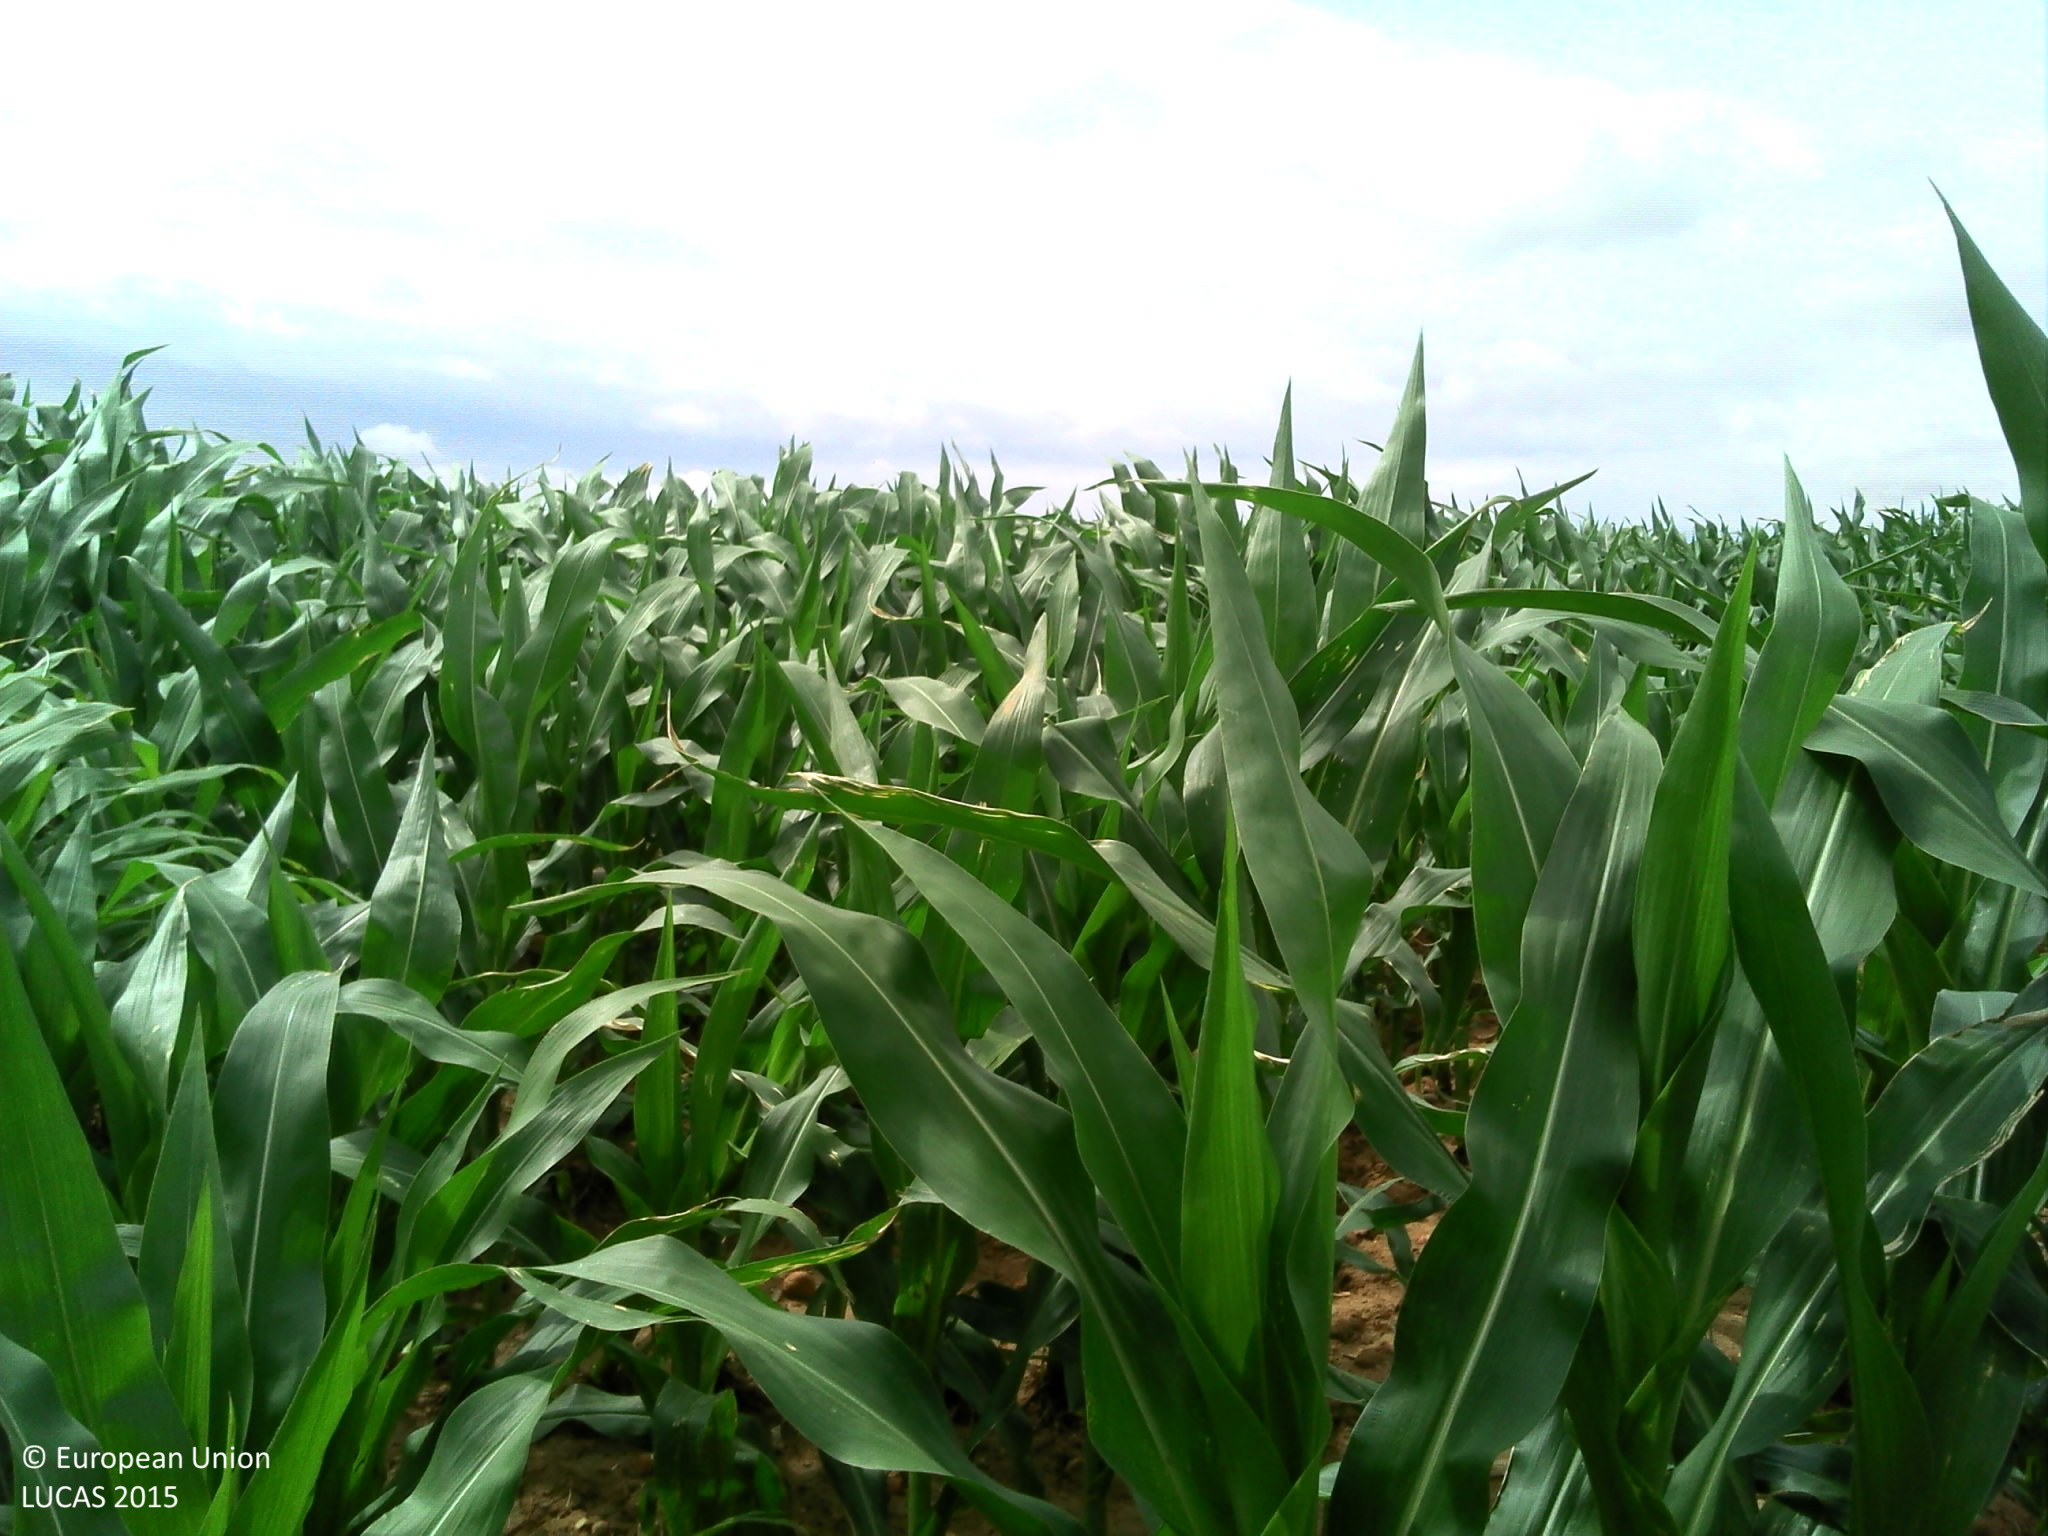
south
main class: Cropland
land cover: Maize
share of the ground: > 75 %
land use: Agriculture (excluding fallow land and kitchen gardens)
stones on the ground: 25 - 50 %
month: June
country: FR
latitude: 45.1647
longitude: 4.9035
